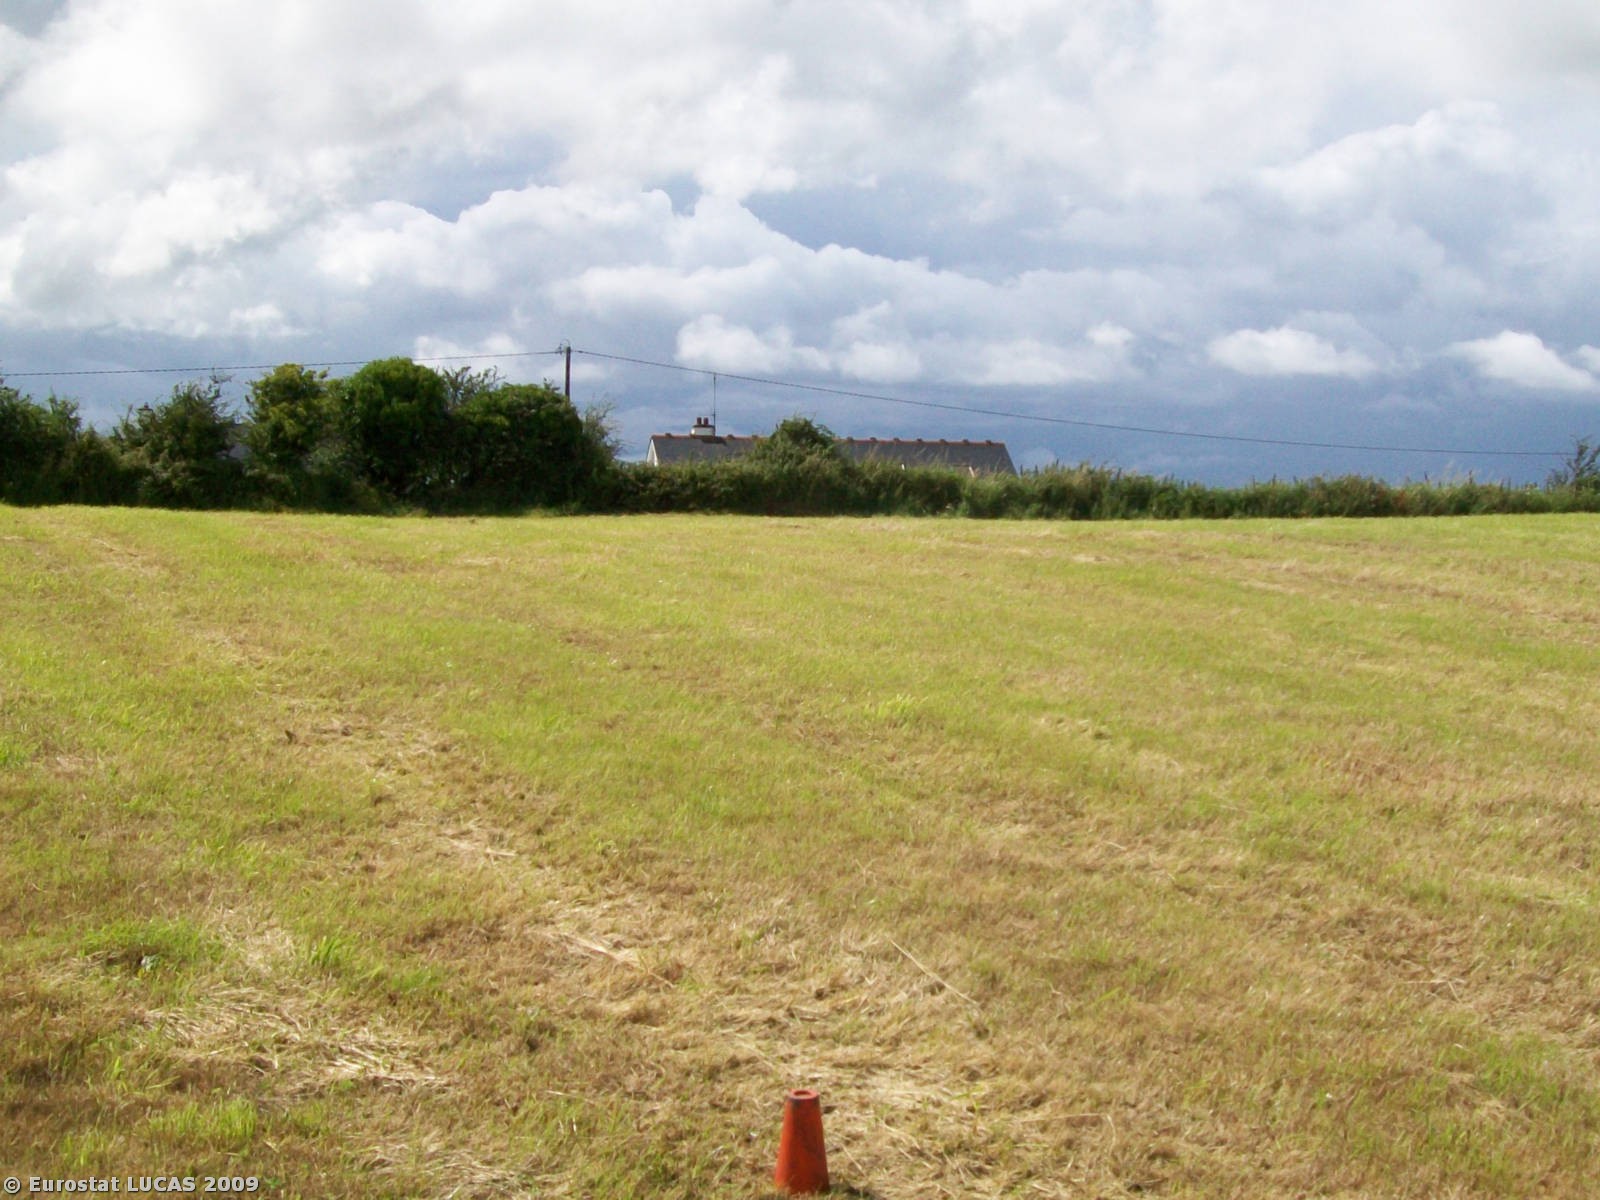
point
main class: Grassland
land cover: Grassland without tree/shrub cover
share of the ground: > 75 %
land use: Agriculture (excluding fallow land and kitchen gardens)
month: July
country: IE
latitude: 53.1938
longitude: -8.7480
